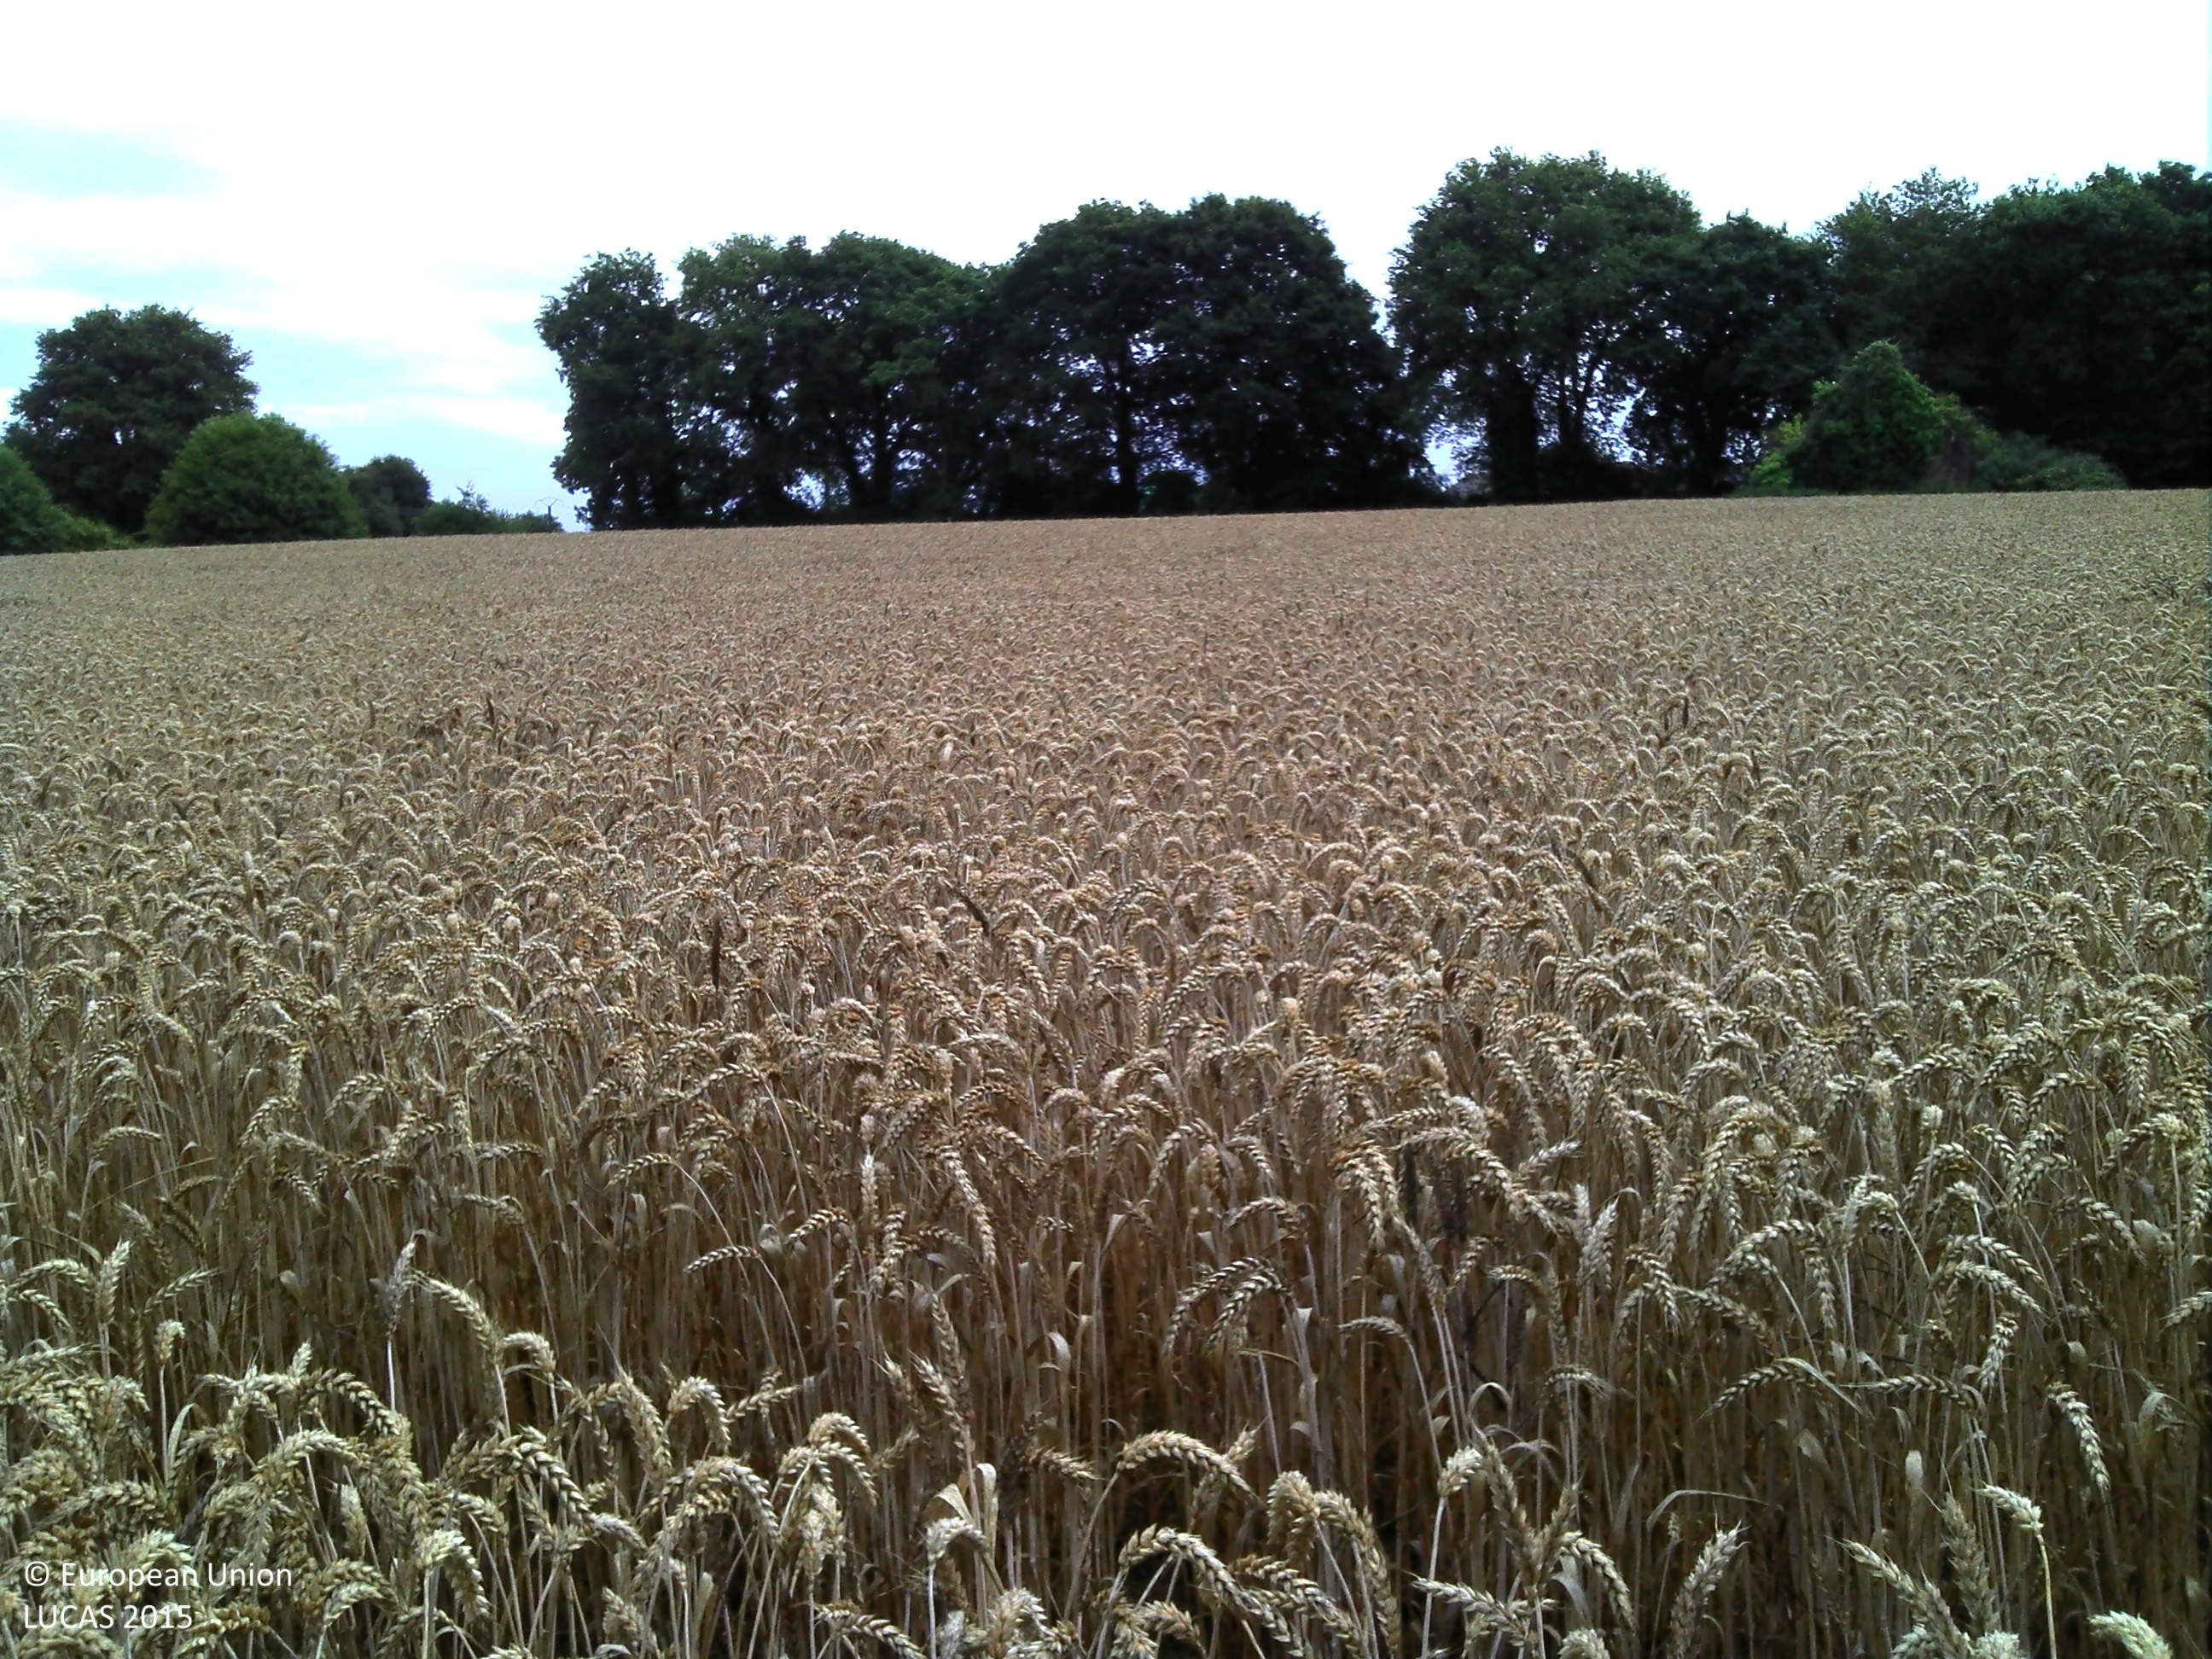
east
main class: Cropland
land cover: Common wheat
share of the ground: > 75 %
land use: Agriculture (excluding fallow land and kitchen gardens)
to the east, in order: Common wheat; Lines of trees; Grassland without tree/shrub cover; Artificial constructions in urban areas; Grassland without tree/shrub cover; Lines of trees; Fences; Grassland without tree/shrub cover
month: July
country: FR
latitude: 47.6460
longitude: -2.8834
